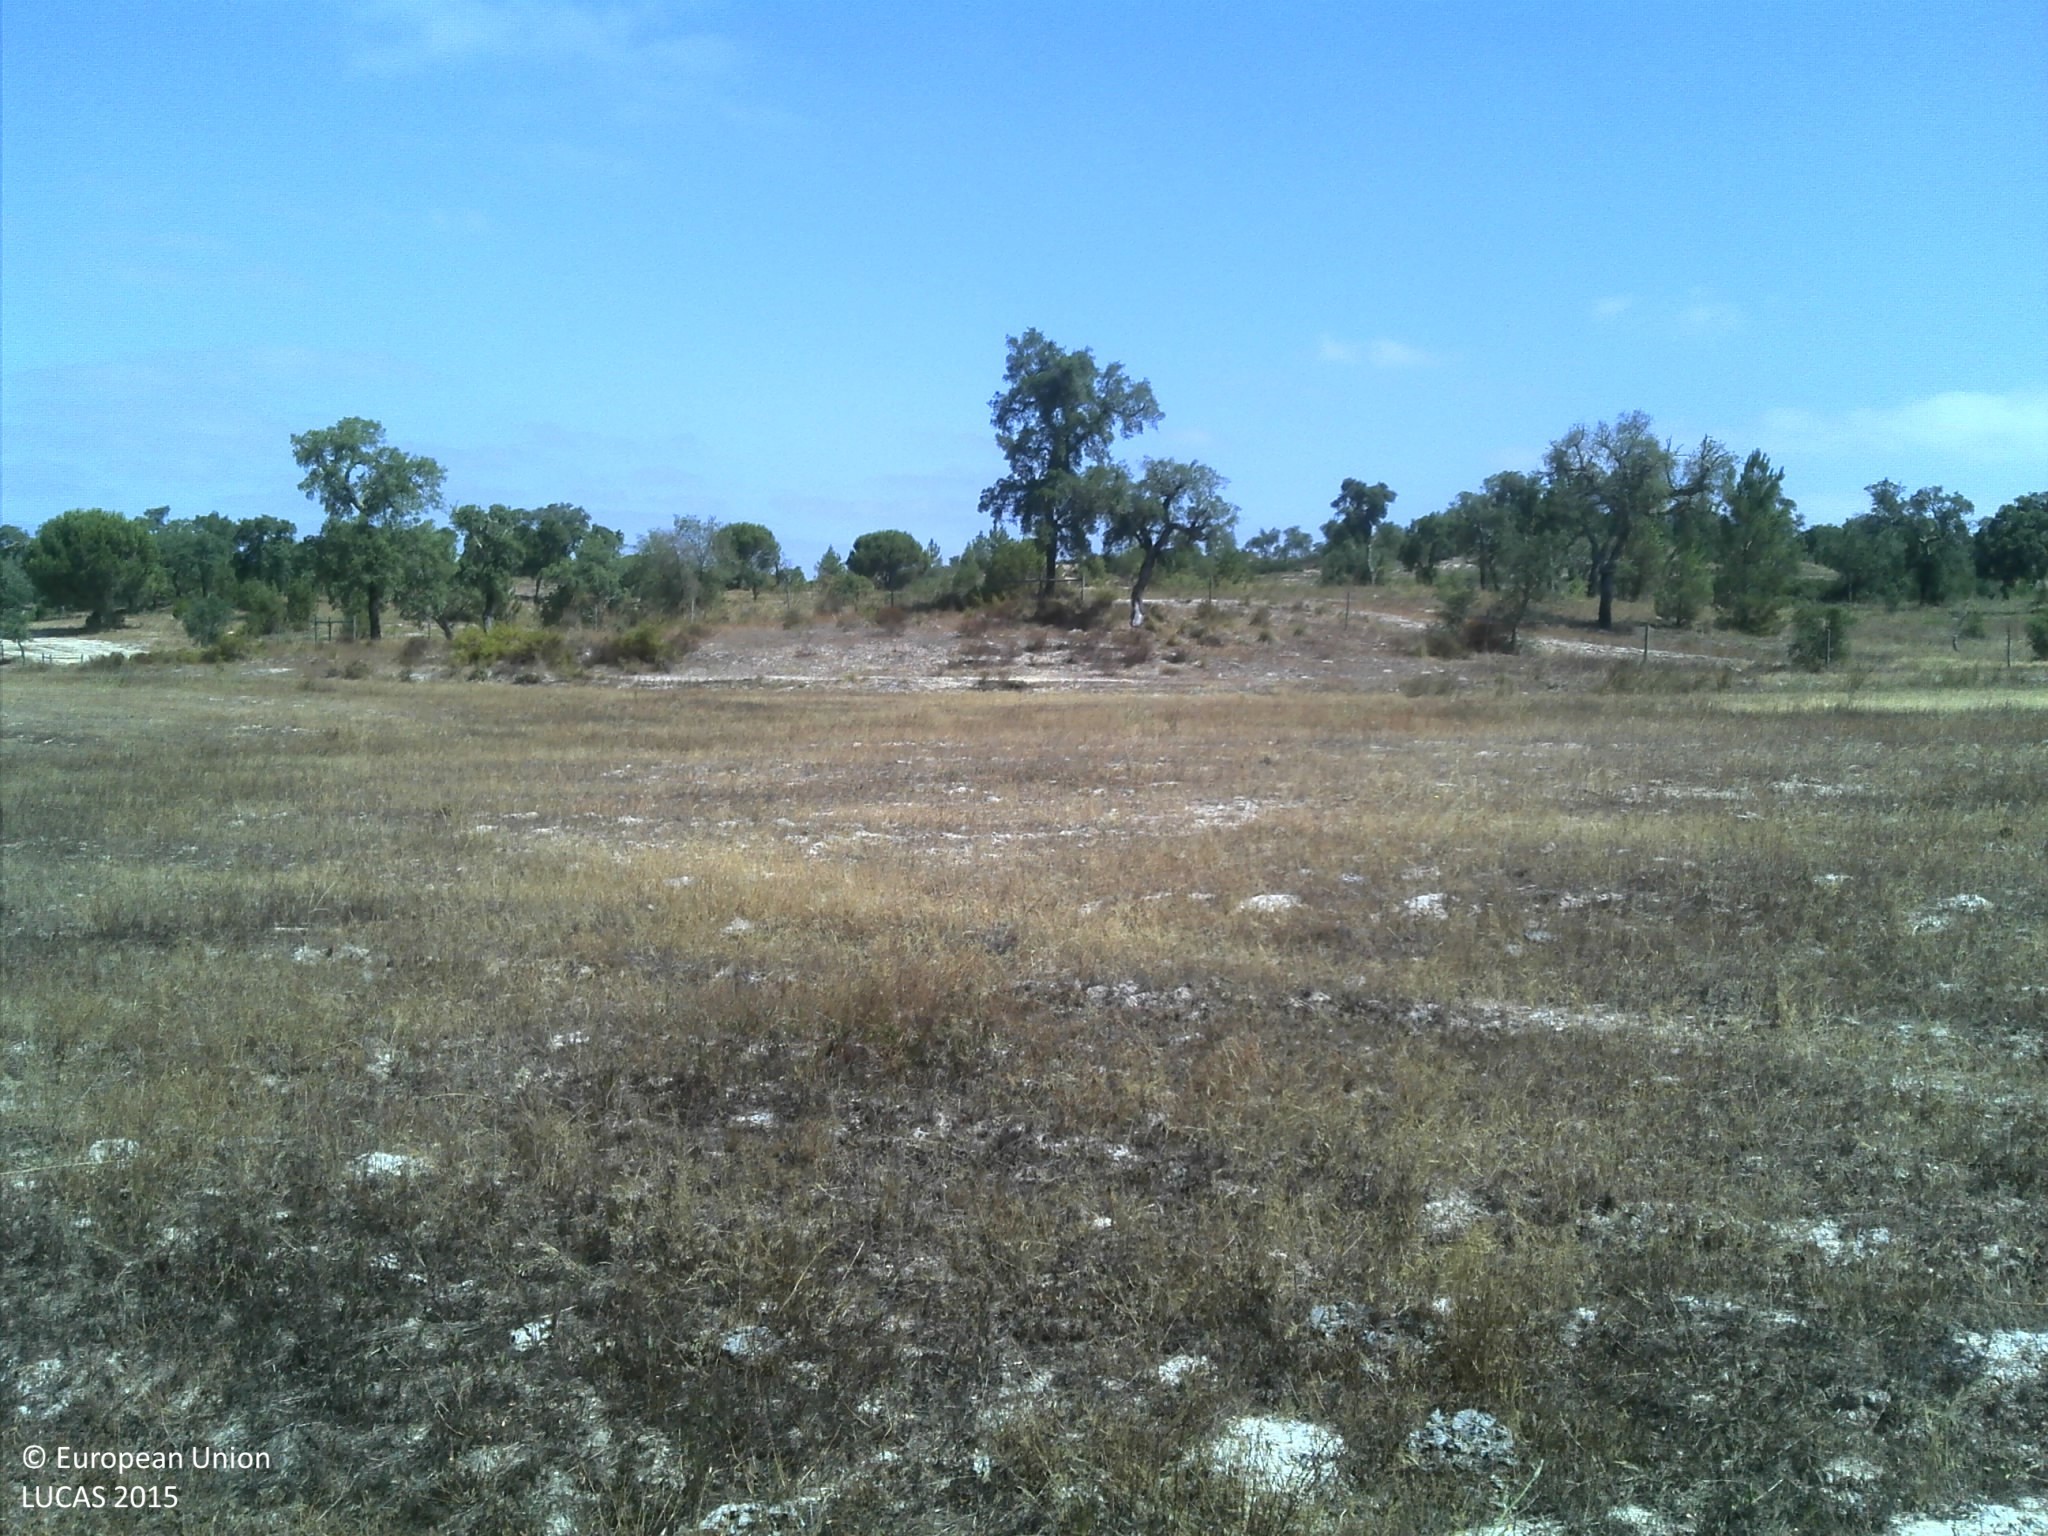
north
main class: Grassland
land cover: Grassland without tree/shrub cover
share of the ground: 25 - 50 %
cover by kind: unconsolidated bare surface 60 %, herbaceous plants 40 %
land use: Agriculture (excluding fallow land and kitchen gardens)
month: July
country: PT
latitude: 39.0643
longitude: -8.3078
